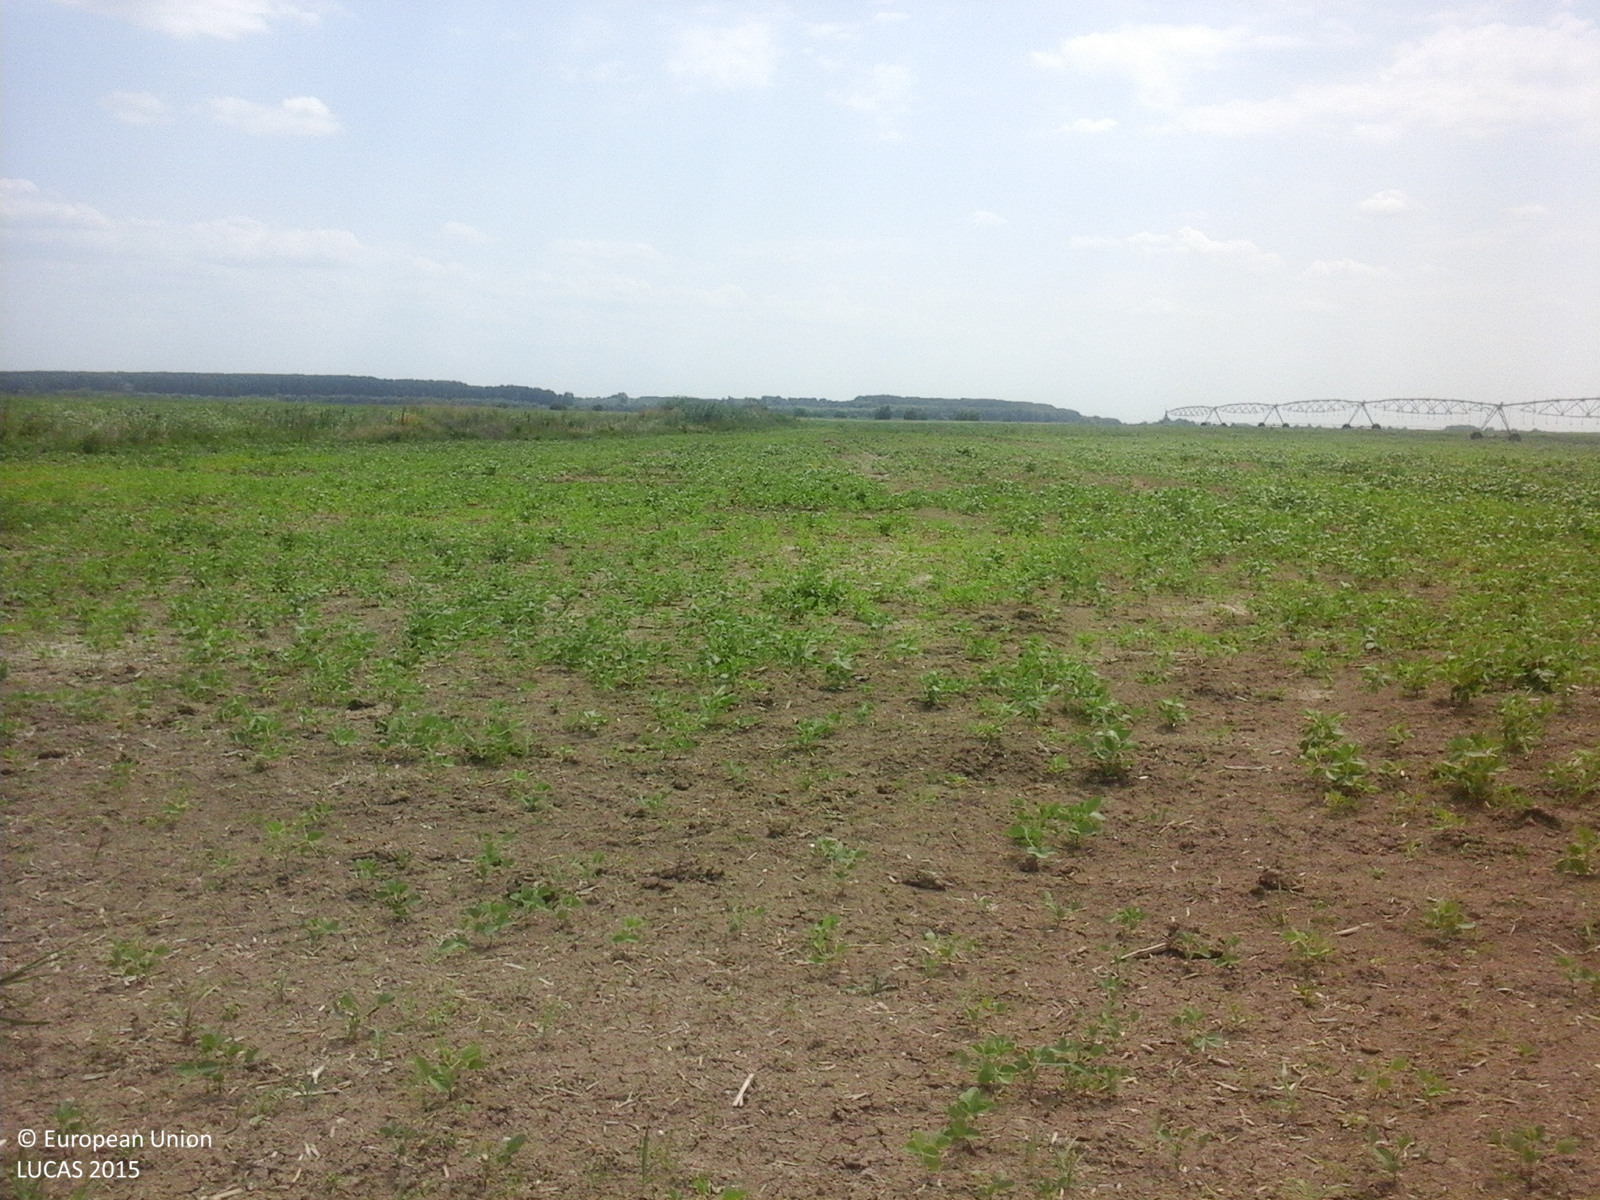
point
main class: Cropland
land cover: Soya
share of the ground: 10 - 25 %
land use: Agriculture (excluding fallow land and kitchen gardens)
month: July
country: RO
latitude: 44.5504
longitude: 27.9953
